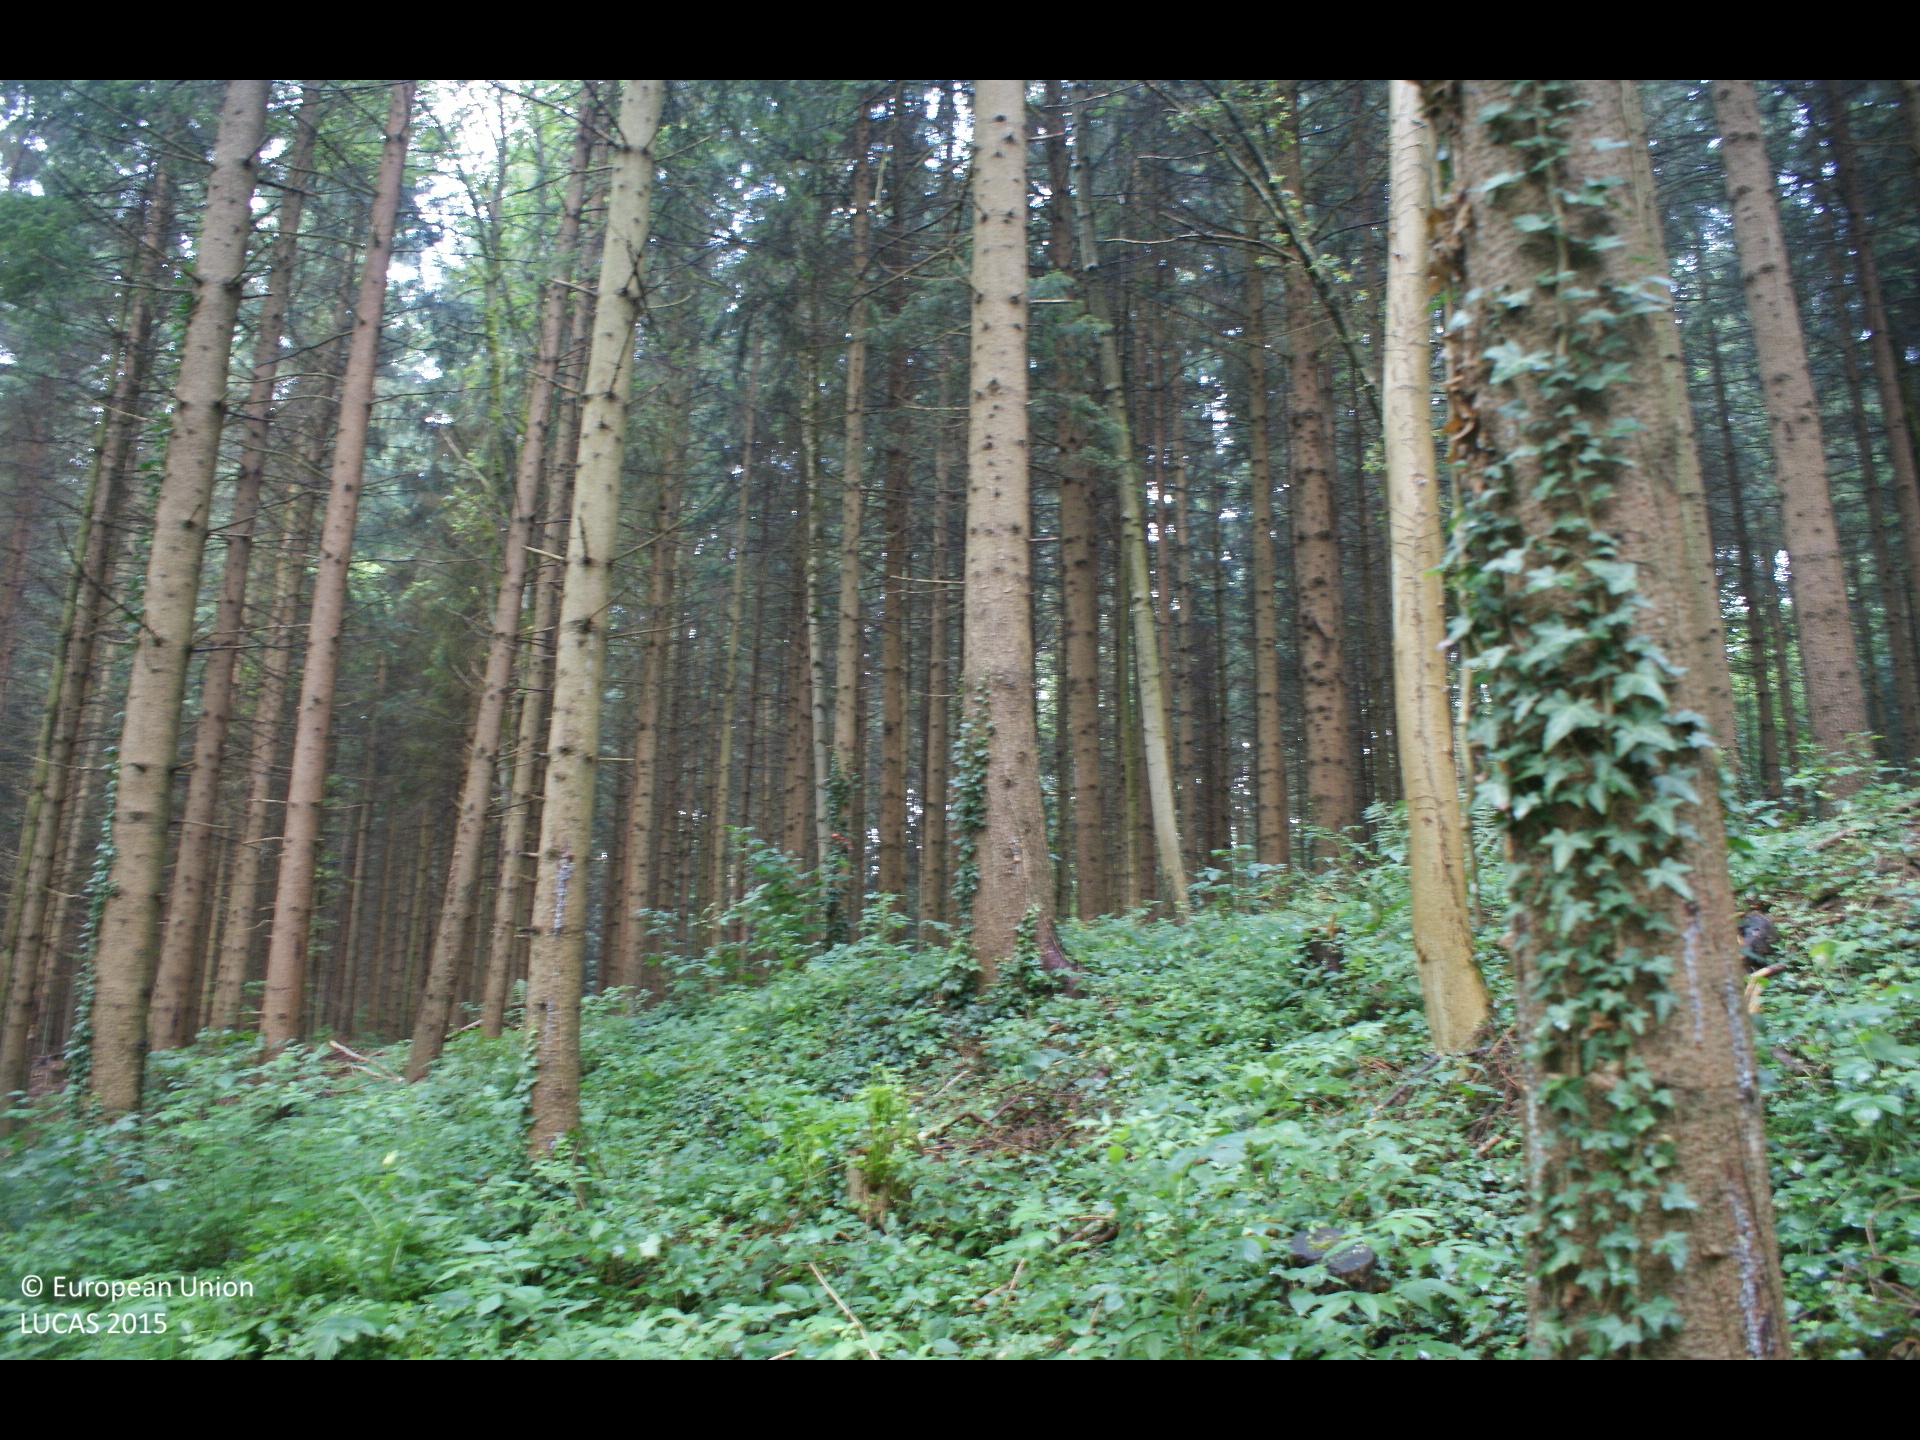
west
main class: Woodland
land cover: Spruce dominated mixed woodland
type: alpine coniferous forest
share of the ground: > 75 %
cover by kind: coniferous forest trees 60 %, broadleaved forest trees 25 %, herbaceous plants 10 %, shrubs 5 %
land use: Forestry
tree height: > 5 m
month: July
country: AT
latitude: 47.9495
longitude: 13.5740
